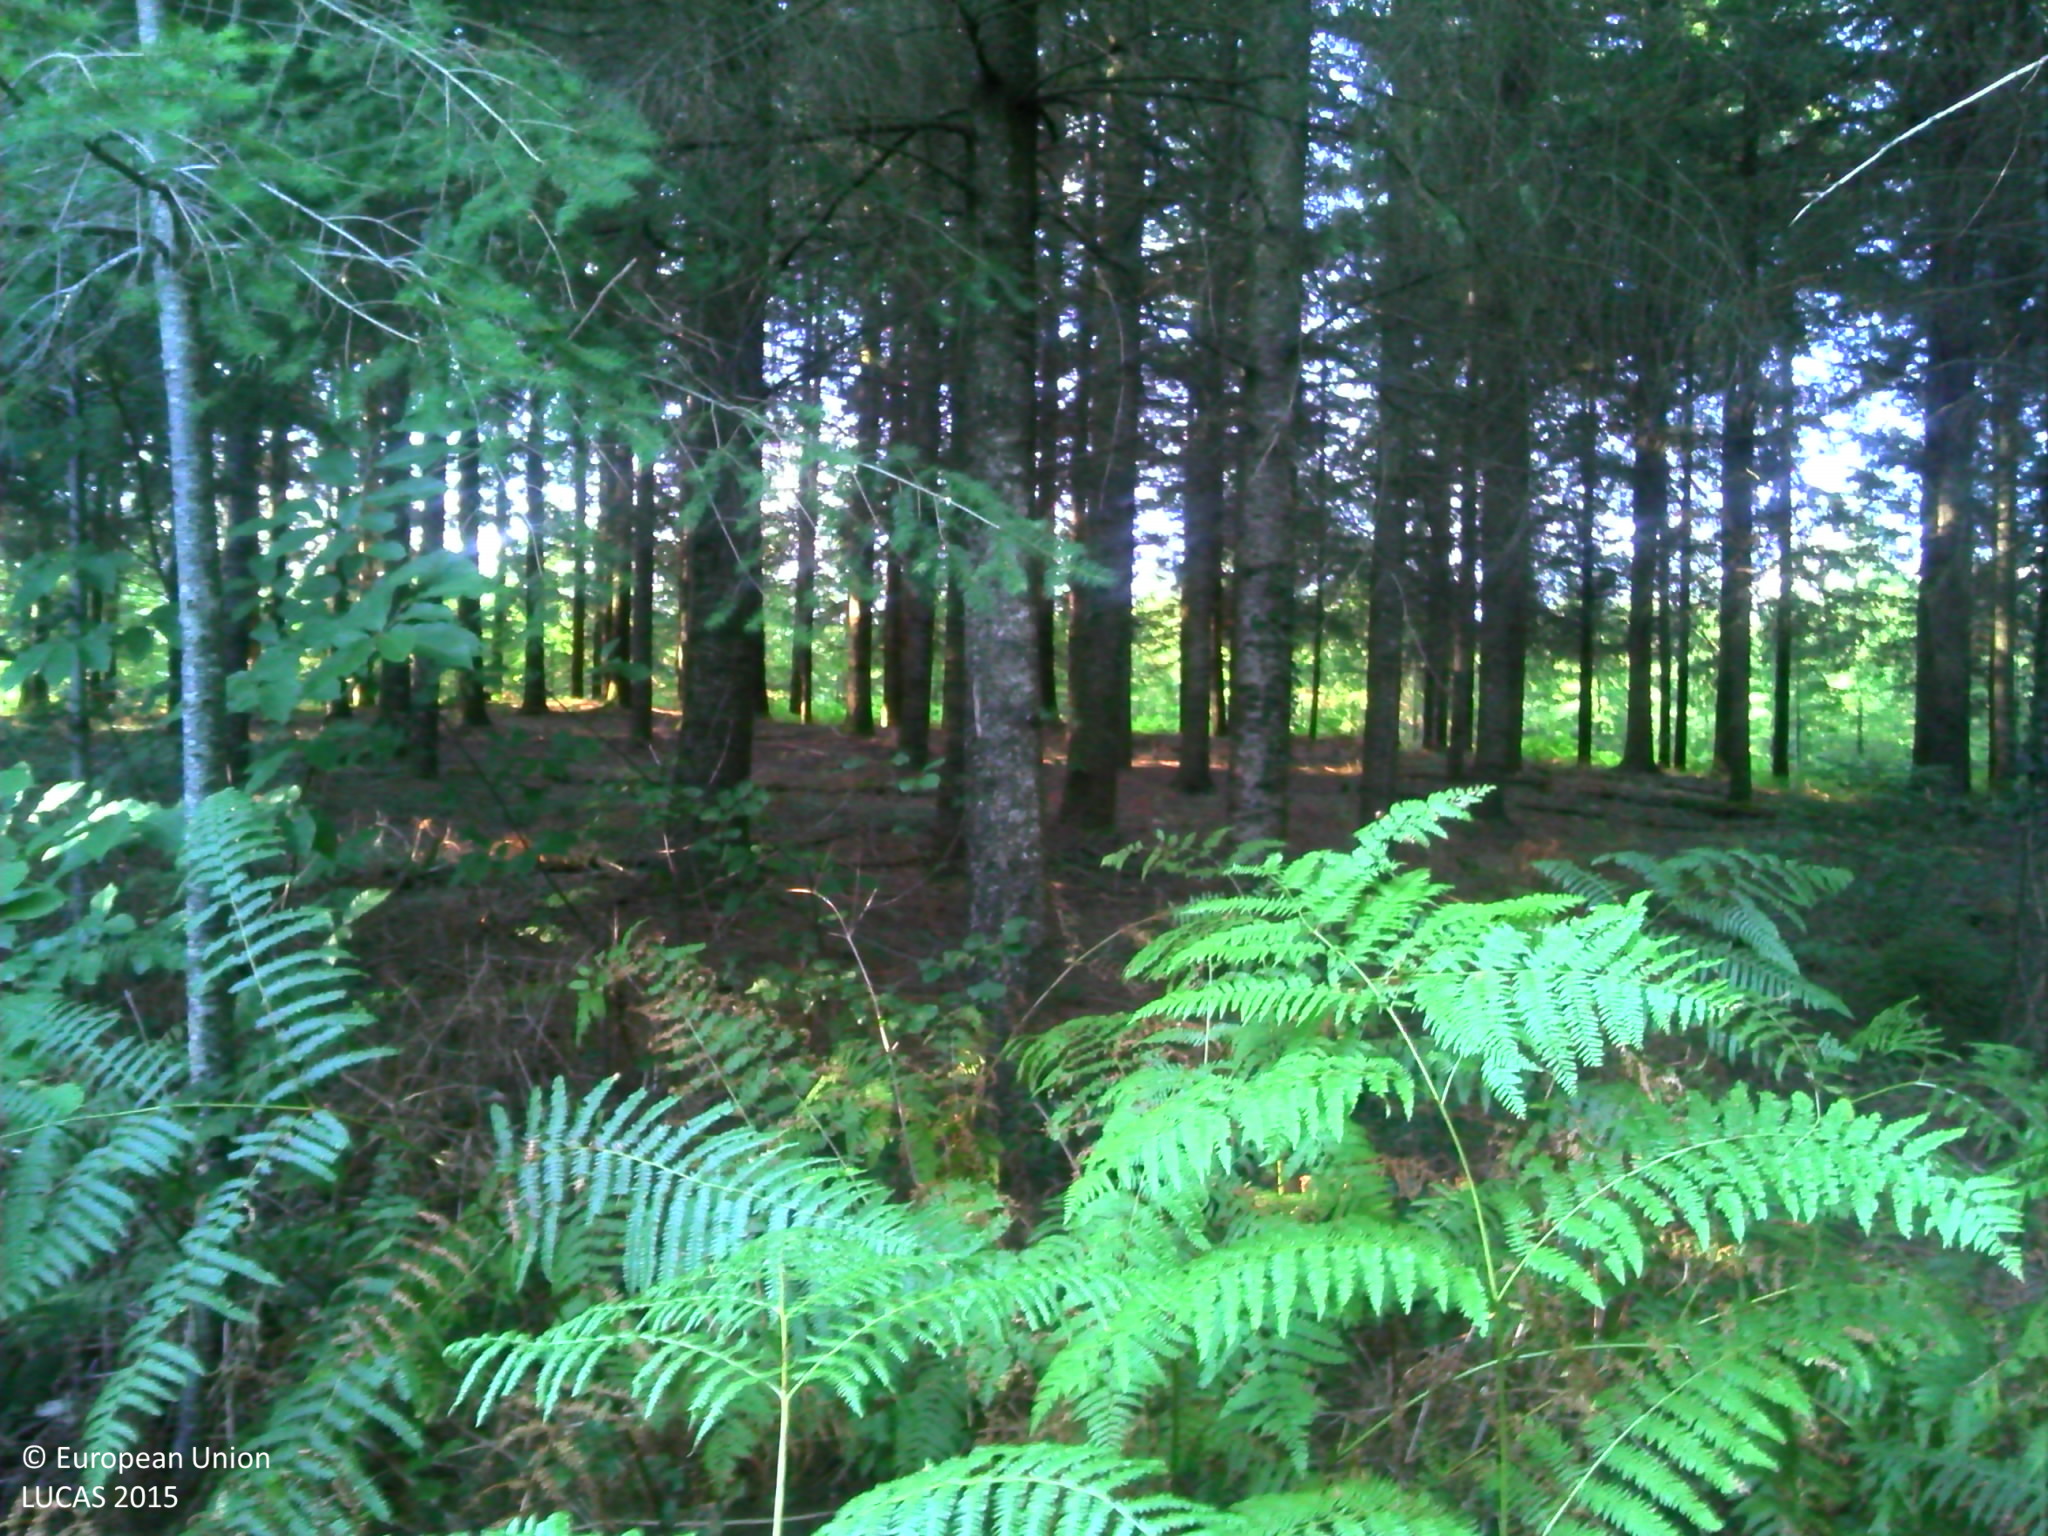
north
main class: Woodland
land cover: Other coniferous woodland
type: exotic forest
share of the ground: > 75 %
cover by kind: coniferous forest trees 70 %, herbaceous plants 15 %, broadleaved forest trees 5 %, shrubs 5 %, lichens and mosses 5 %
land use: Forestry
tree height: > 5 m
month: August
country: FR
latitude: 45.8860
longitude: 1.7335
